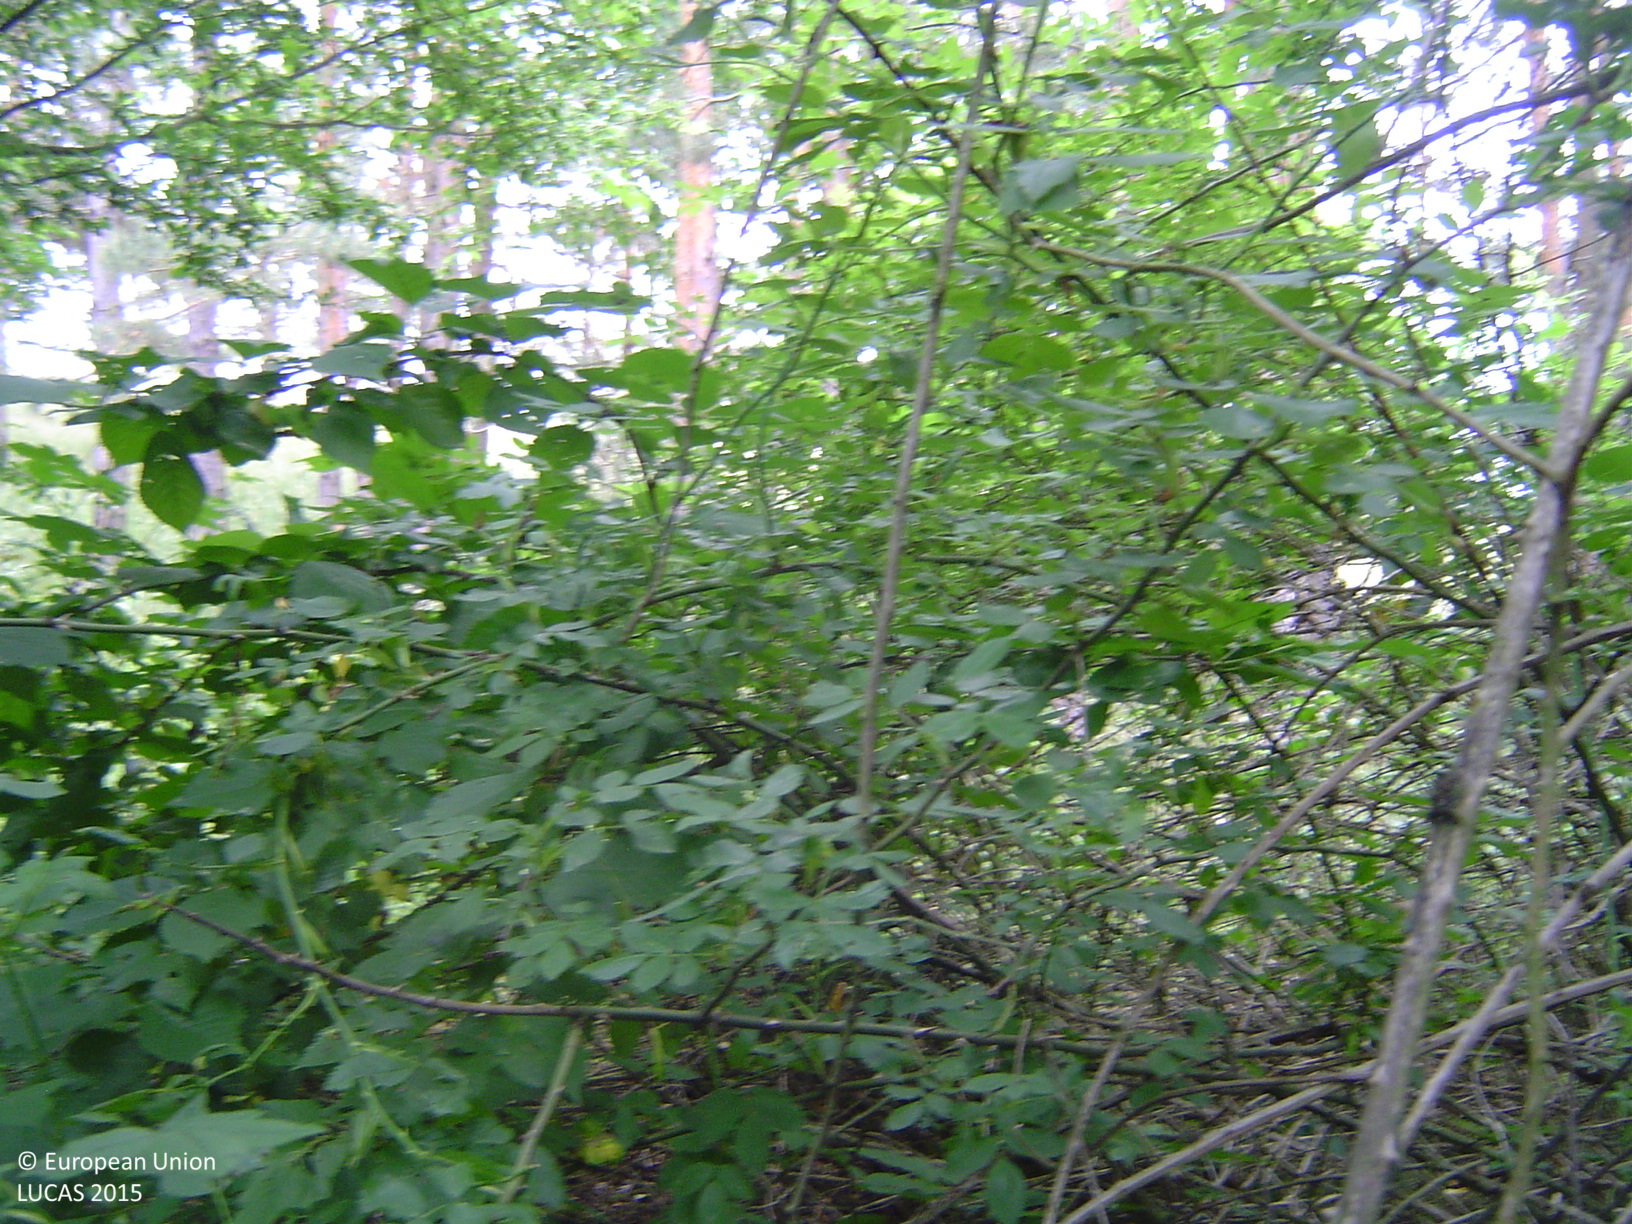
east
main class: Woodland
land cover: Pine dominated mixed woodland
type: hemiboreal forest and nemoral coniferous forest and mixed broadleaved-coniferous forest
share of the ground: > 75 %
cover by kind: coniferous forest trees 70 %, broadleaved forest trees 25 %, shrubs 5 %
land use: Forestry
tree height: > 5 m
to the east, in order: Pine dominated mixed woodland; Grassland with sparse tree/shrub cover; Grassland without tree/shrub cover; Tracks; Grassland without tree/shrub cover; Maize
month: June
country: CZ
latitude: 49.1294
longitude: 16.2414
